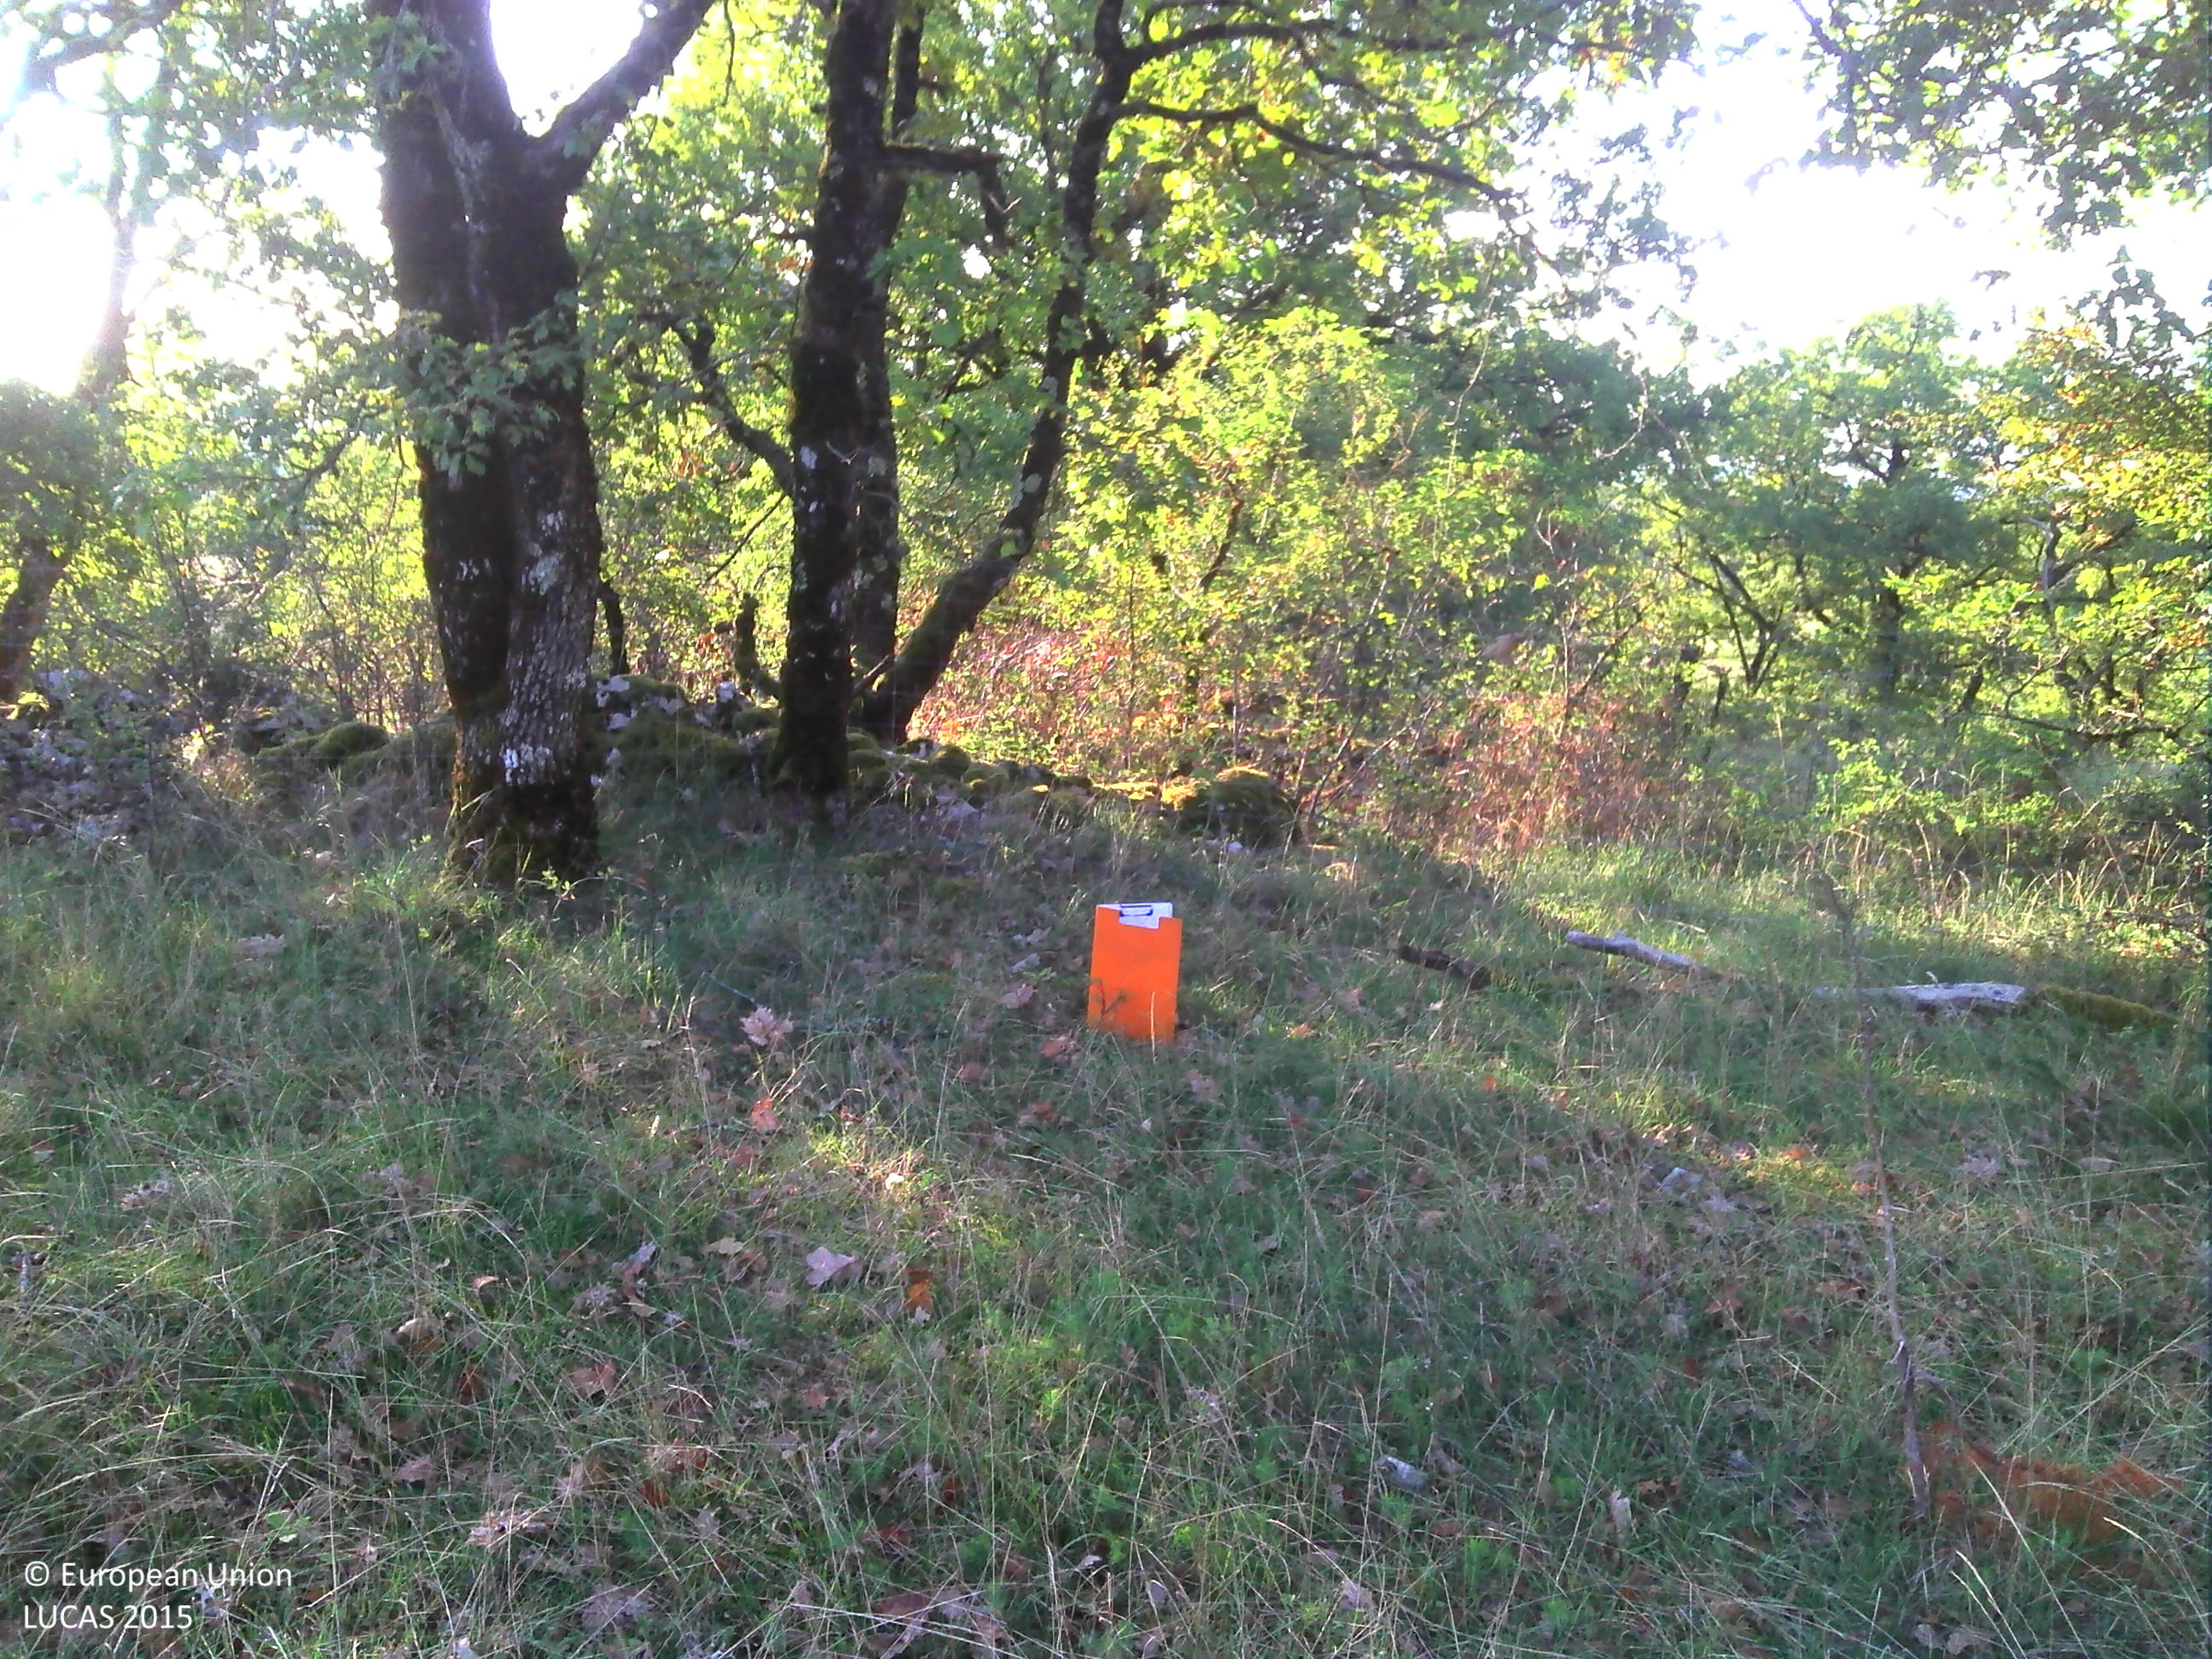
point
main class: Woodland
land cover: Broadleaved woodland
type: mesophytic deciduous forest
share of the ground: > 75 %
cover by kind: herbaceous plants 50 %, broadleaved forest trees 40 %, shrubs 10 %
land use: Forestry
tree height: > 5 m
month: September
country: FR
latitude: 44.6111
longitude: 1.6440
